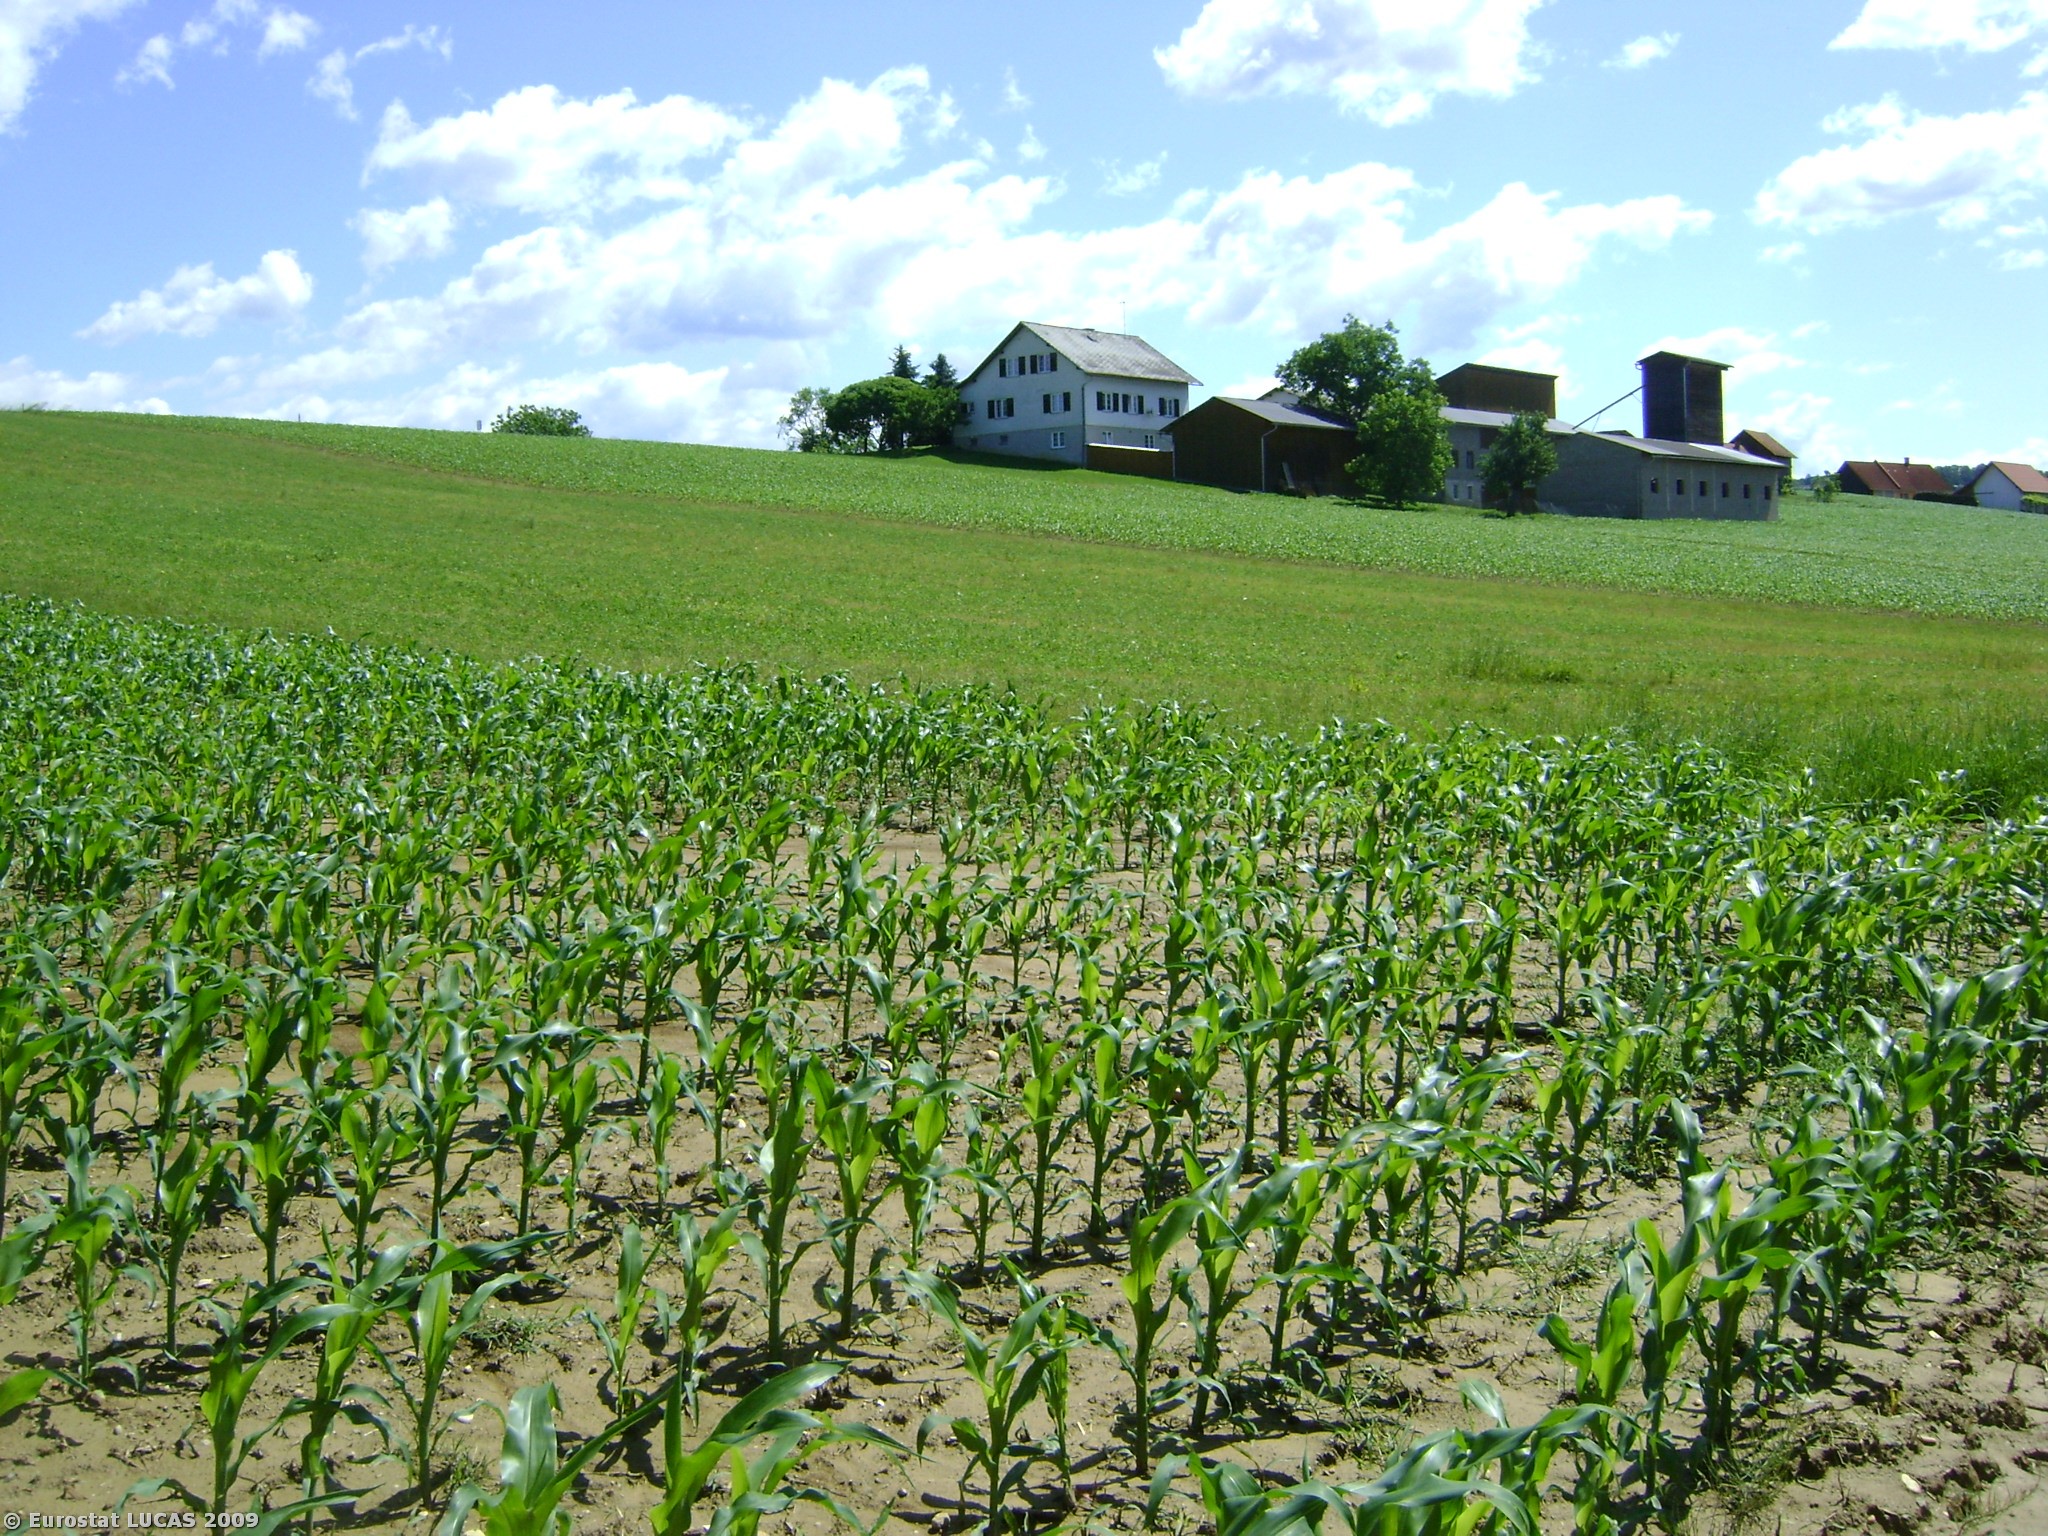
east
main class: Cropland
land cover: Maize
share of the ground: 25 - 50 %
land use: Agriculture (excluding fallow land and kitchen gardens)
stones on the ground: < 10 %
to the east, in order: Maize; Grassland without tree/shrub cover; Maize; Ditches and canals; Paved roads, cycling and walking lanes; Grass margins; Maize; Grassland without tree/shrub cover; Artificial constructions in urban areas; Grassland with sparse tree/shrub cover; Paved roads, cycling and walking lanes; Grass margins; Maize
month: May
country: AT
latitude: 46.8130
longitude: 15.7007
